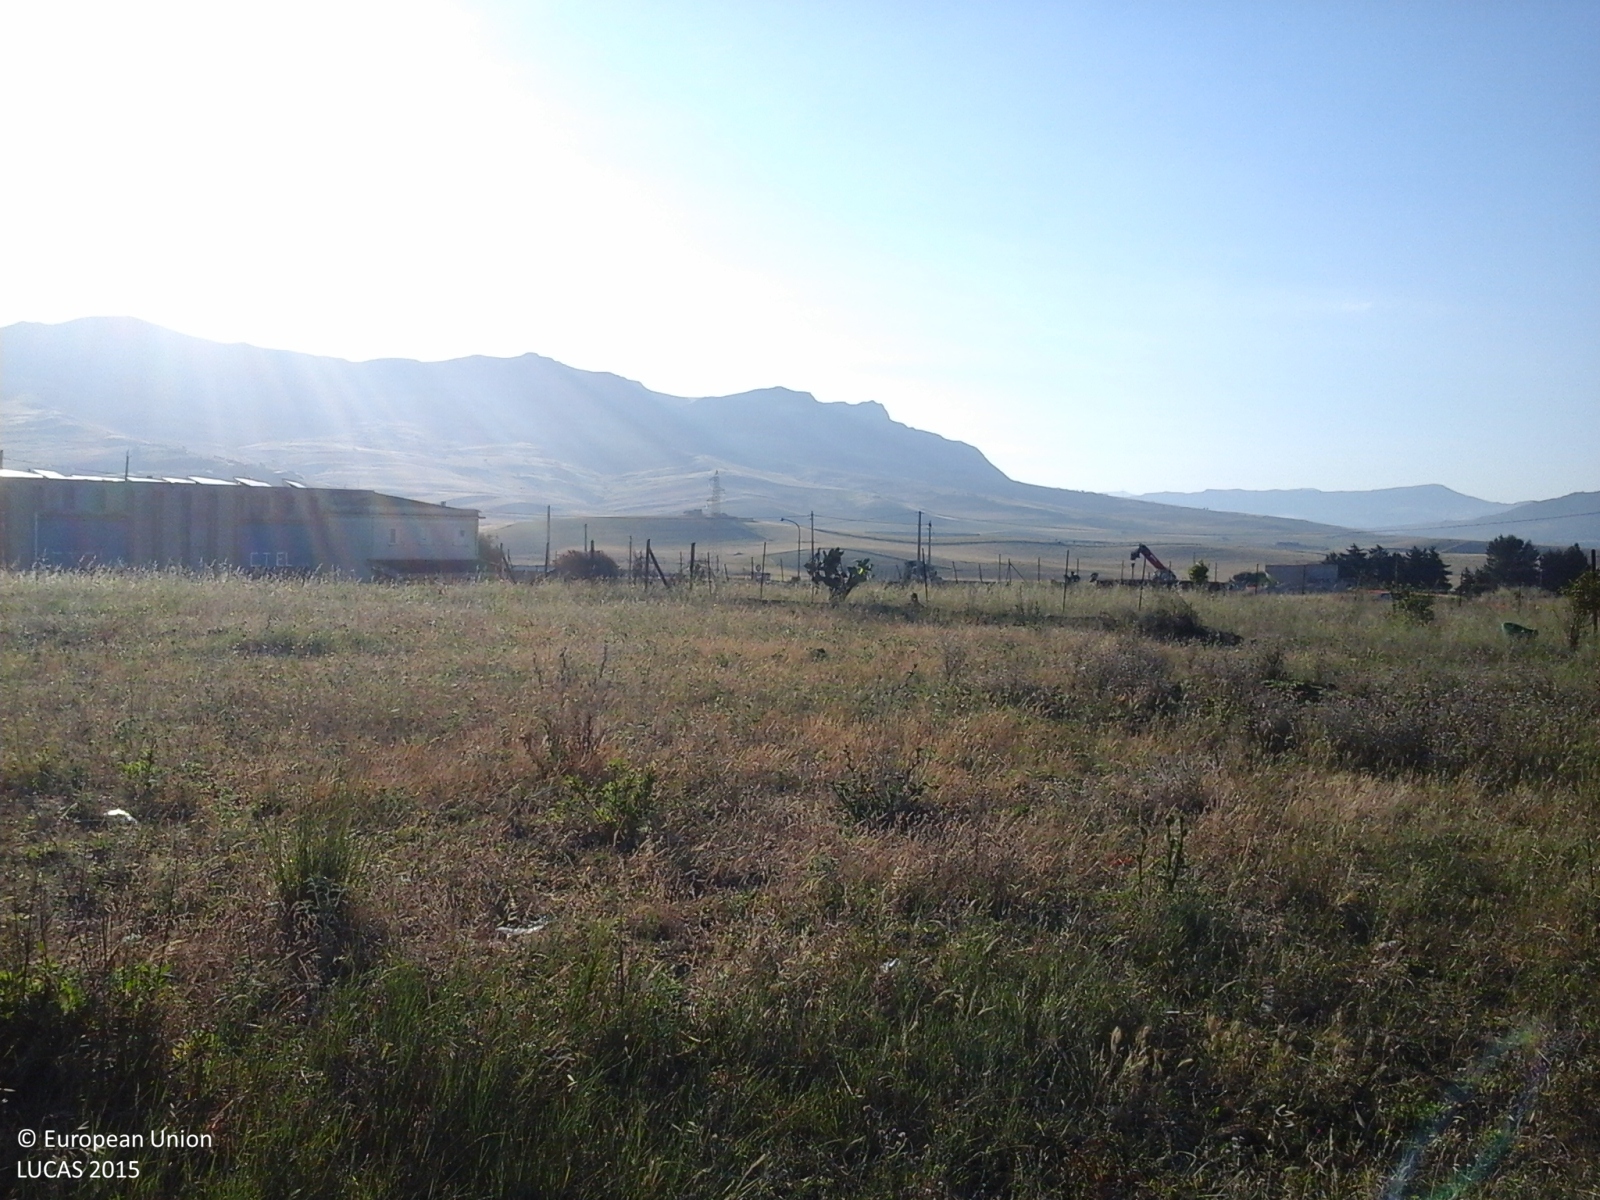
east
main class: Grassland
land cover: Spontaneously vegetated surfaces
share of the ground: > 75 %
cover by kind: herbaceous plants 100 %
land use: Fallow land
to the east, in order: Spontaneously vegetated surfaces; Artificial constructions in urban areas
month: June
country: IT
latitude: 37.8644
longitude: 13.5098
